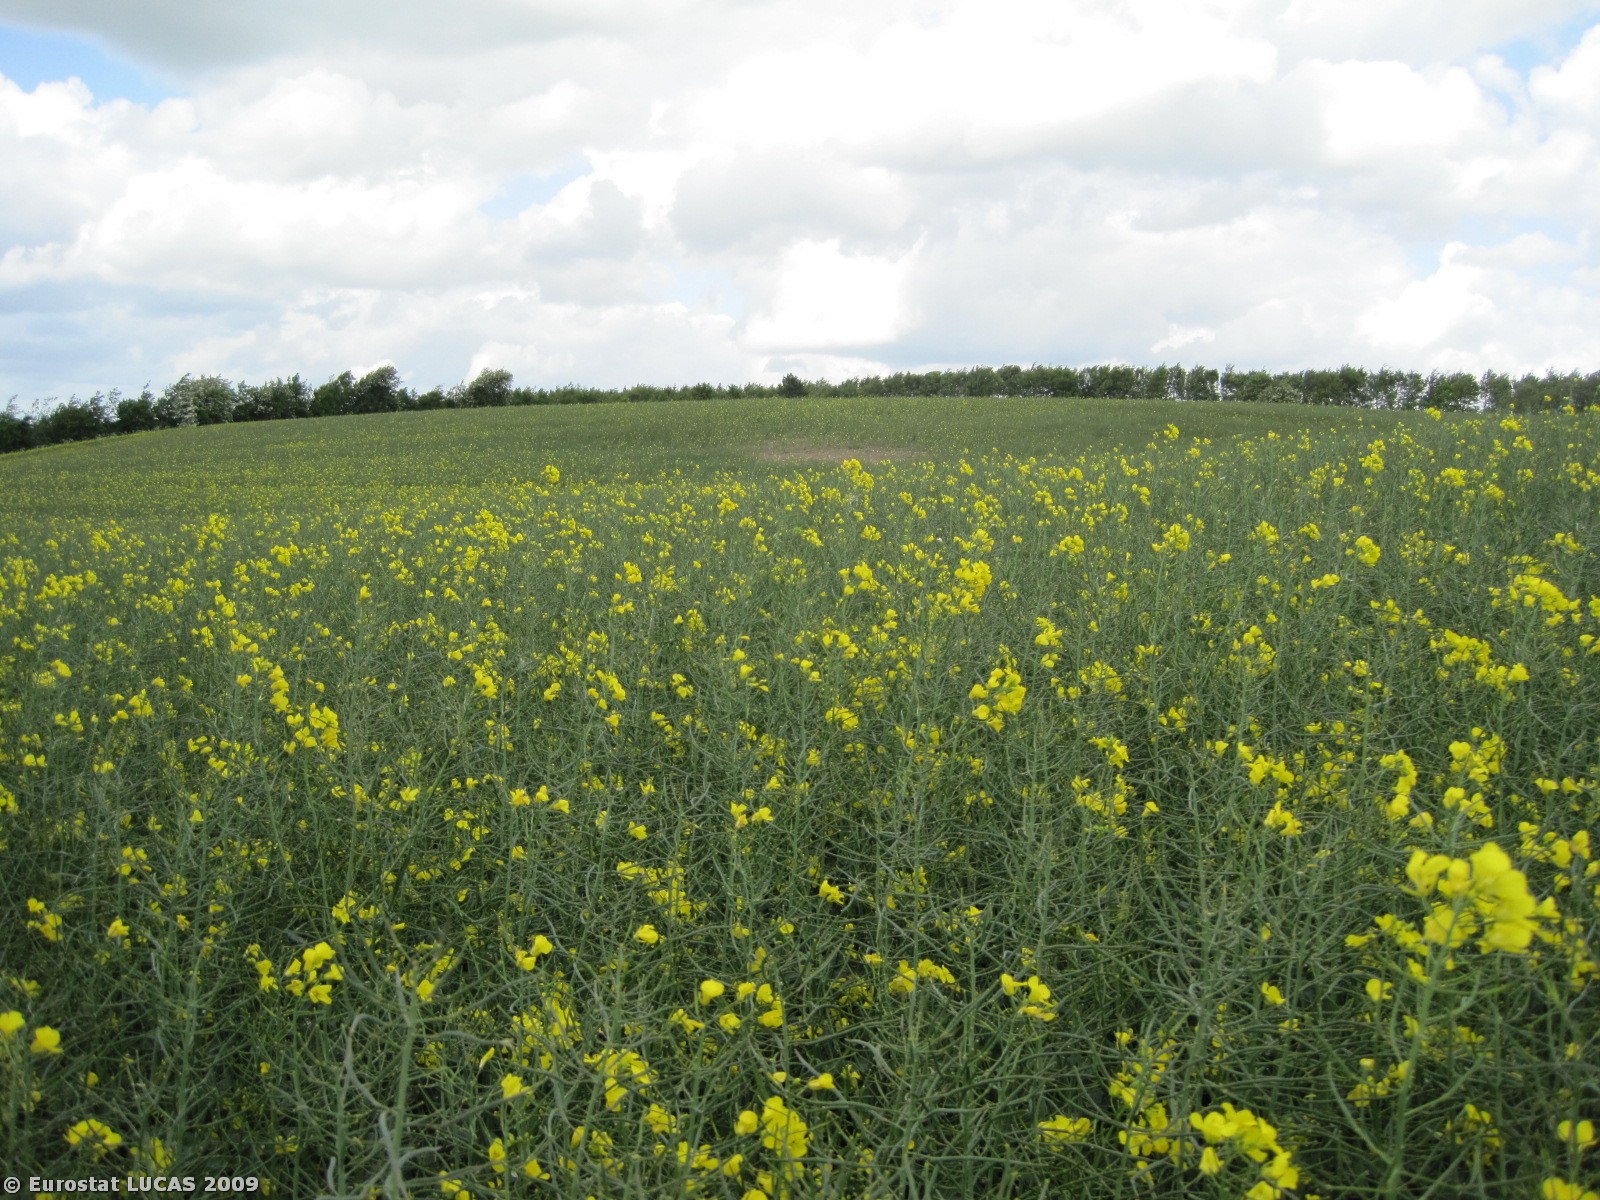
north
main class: Cropland
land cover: Rape and turnip rape
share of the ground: > 75 %
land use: Agriculture (excluding fallow land and kitchen gardens)
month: May
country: DK
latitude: 56.5652
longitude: 9.8862
